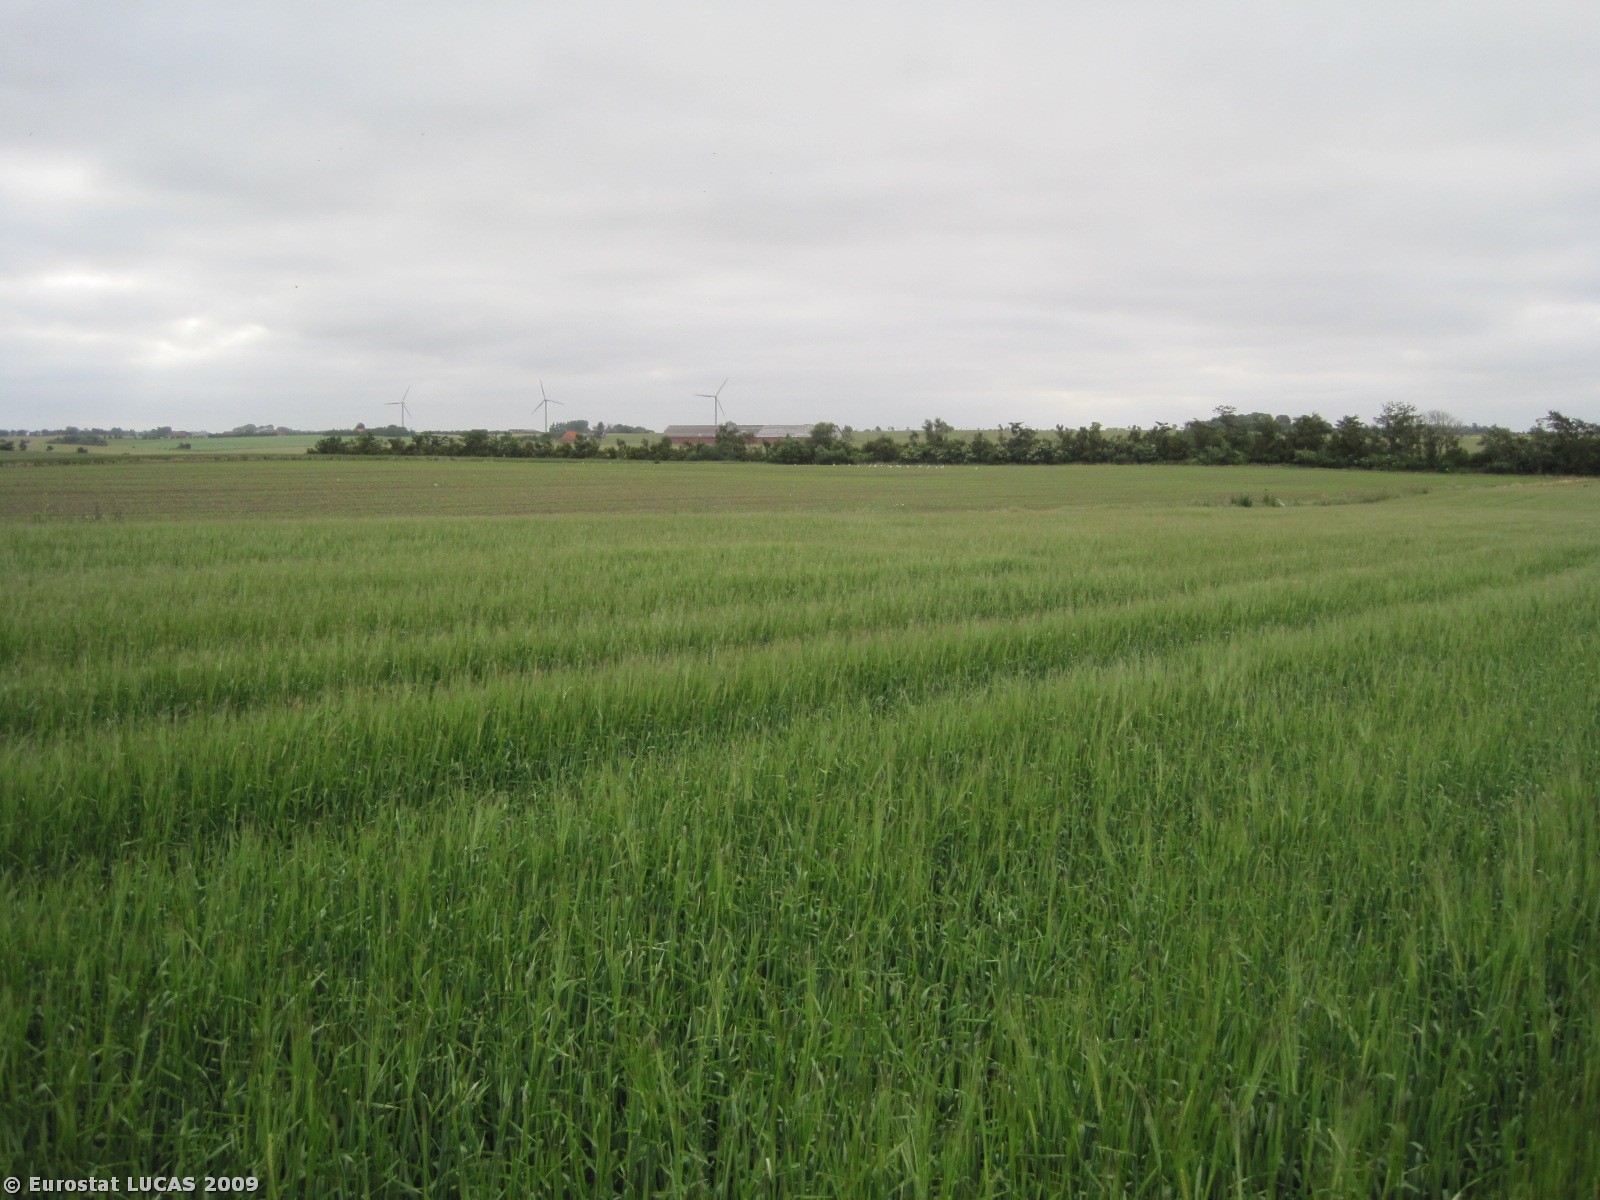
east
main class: Cropland
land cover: Barley
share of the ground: > 75 %
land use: Agriculture (excluding fallow land and kitchen gardens)
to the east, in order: Barley; Grass margins; Maize
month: June
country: DK
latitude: 56.7206
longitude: 8.7108
